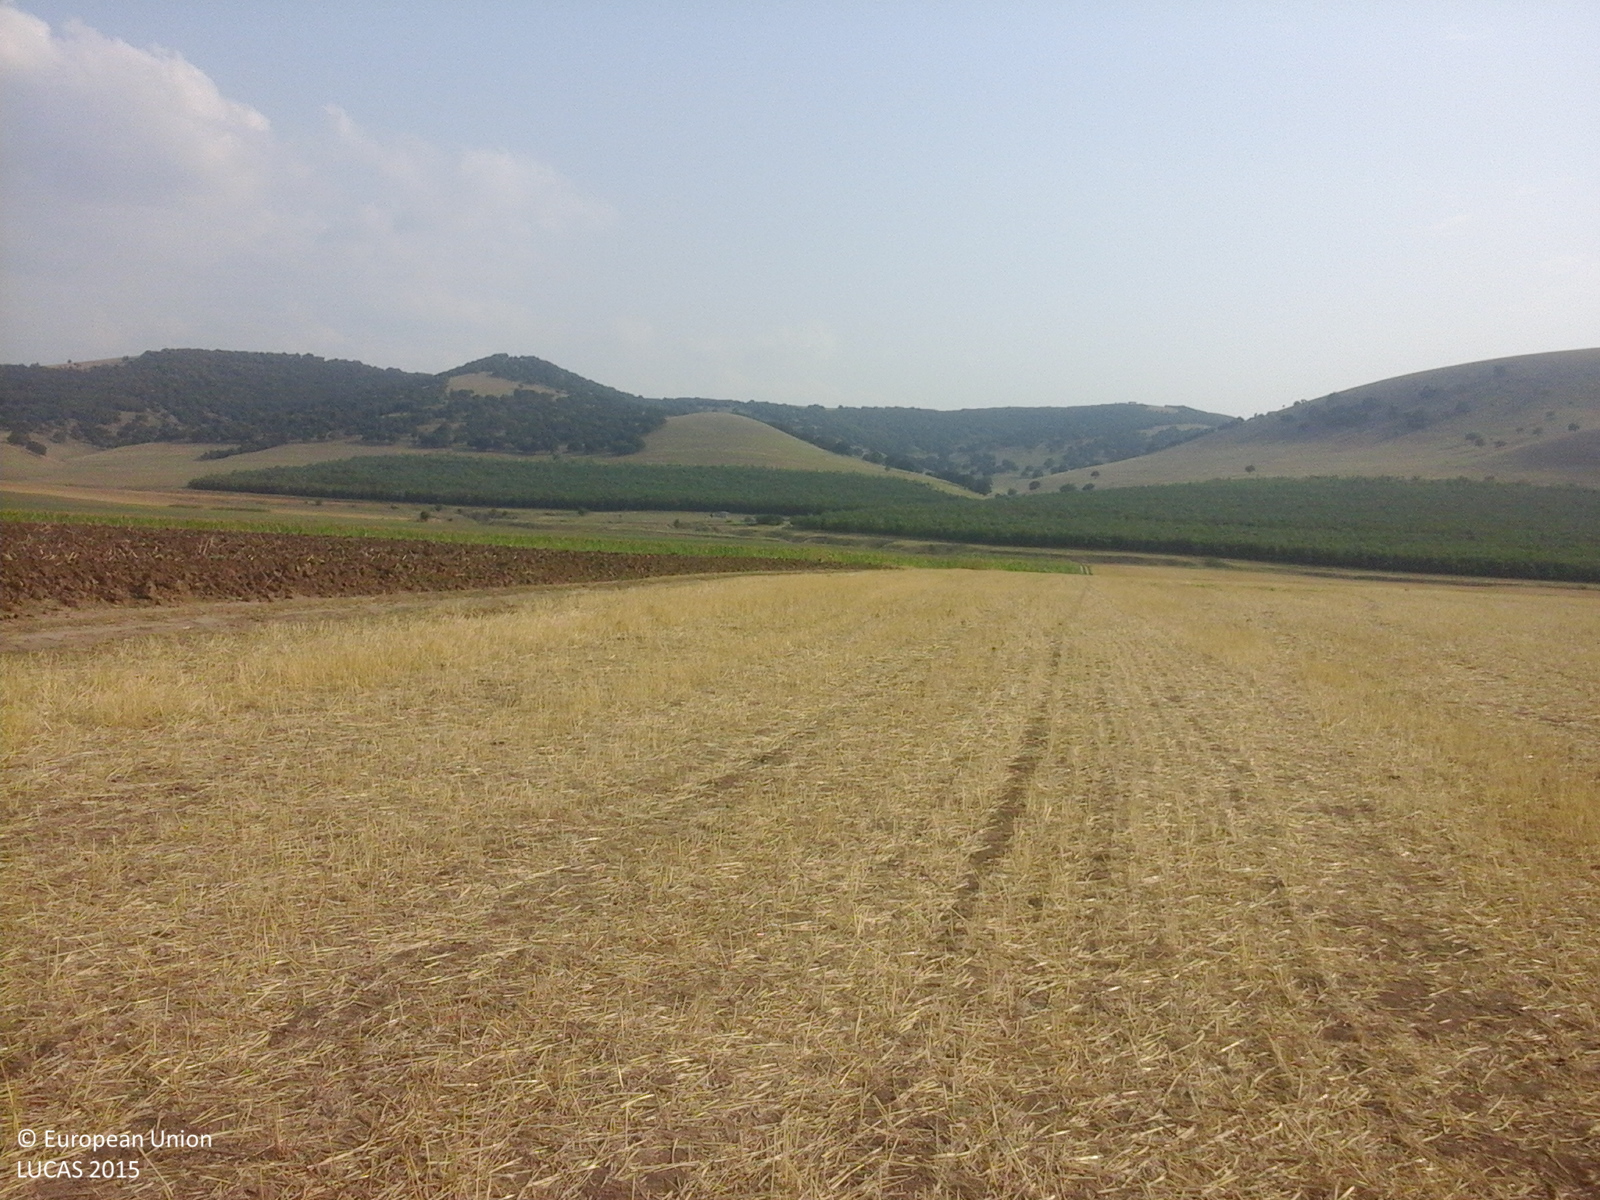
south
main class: Cropland
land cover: Common wheat
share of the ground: 50 - 75 %
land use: Agriculture (excluding fallow land and kitchen gardens)
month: July
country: RO
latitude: 45.0252
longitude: 28.3360
